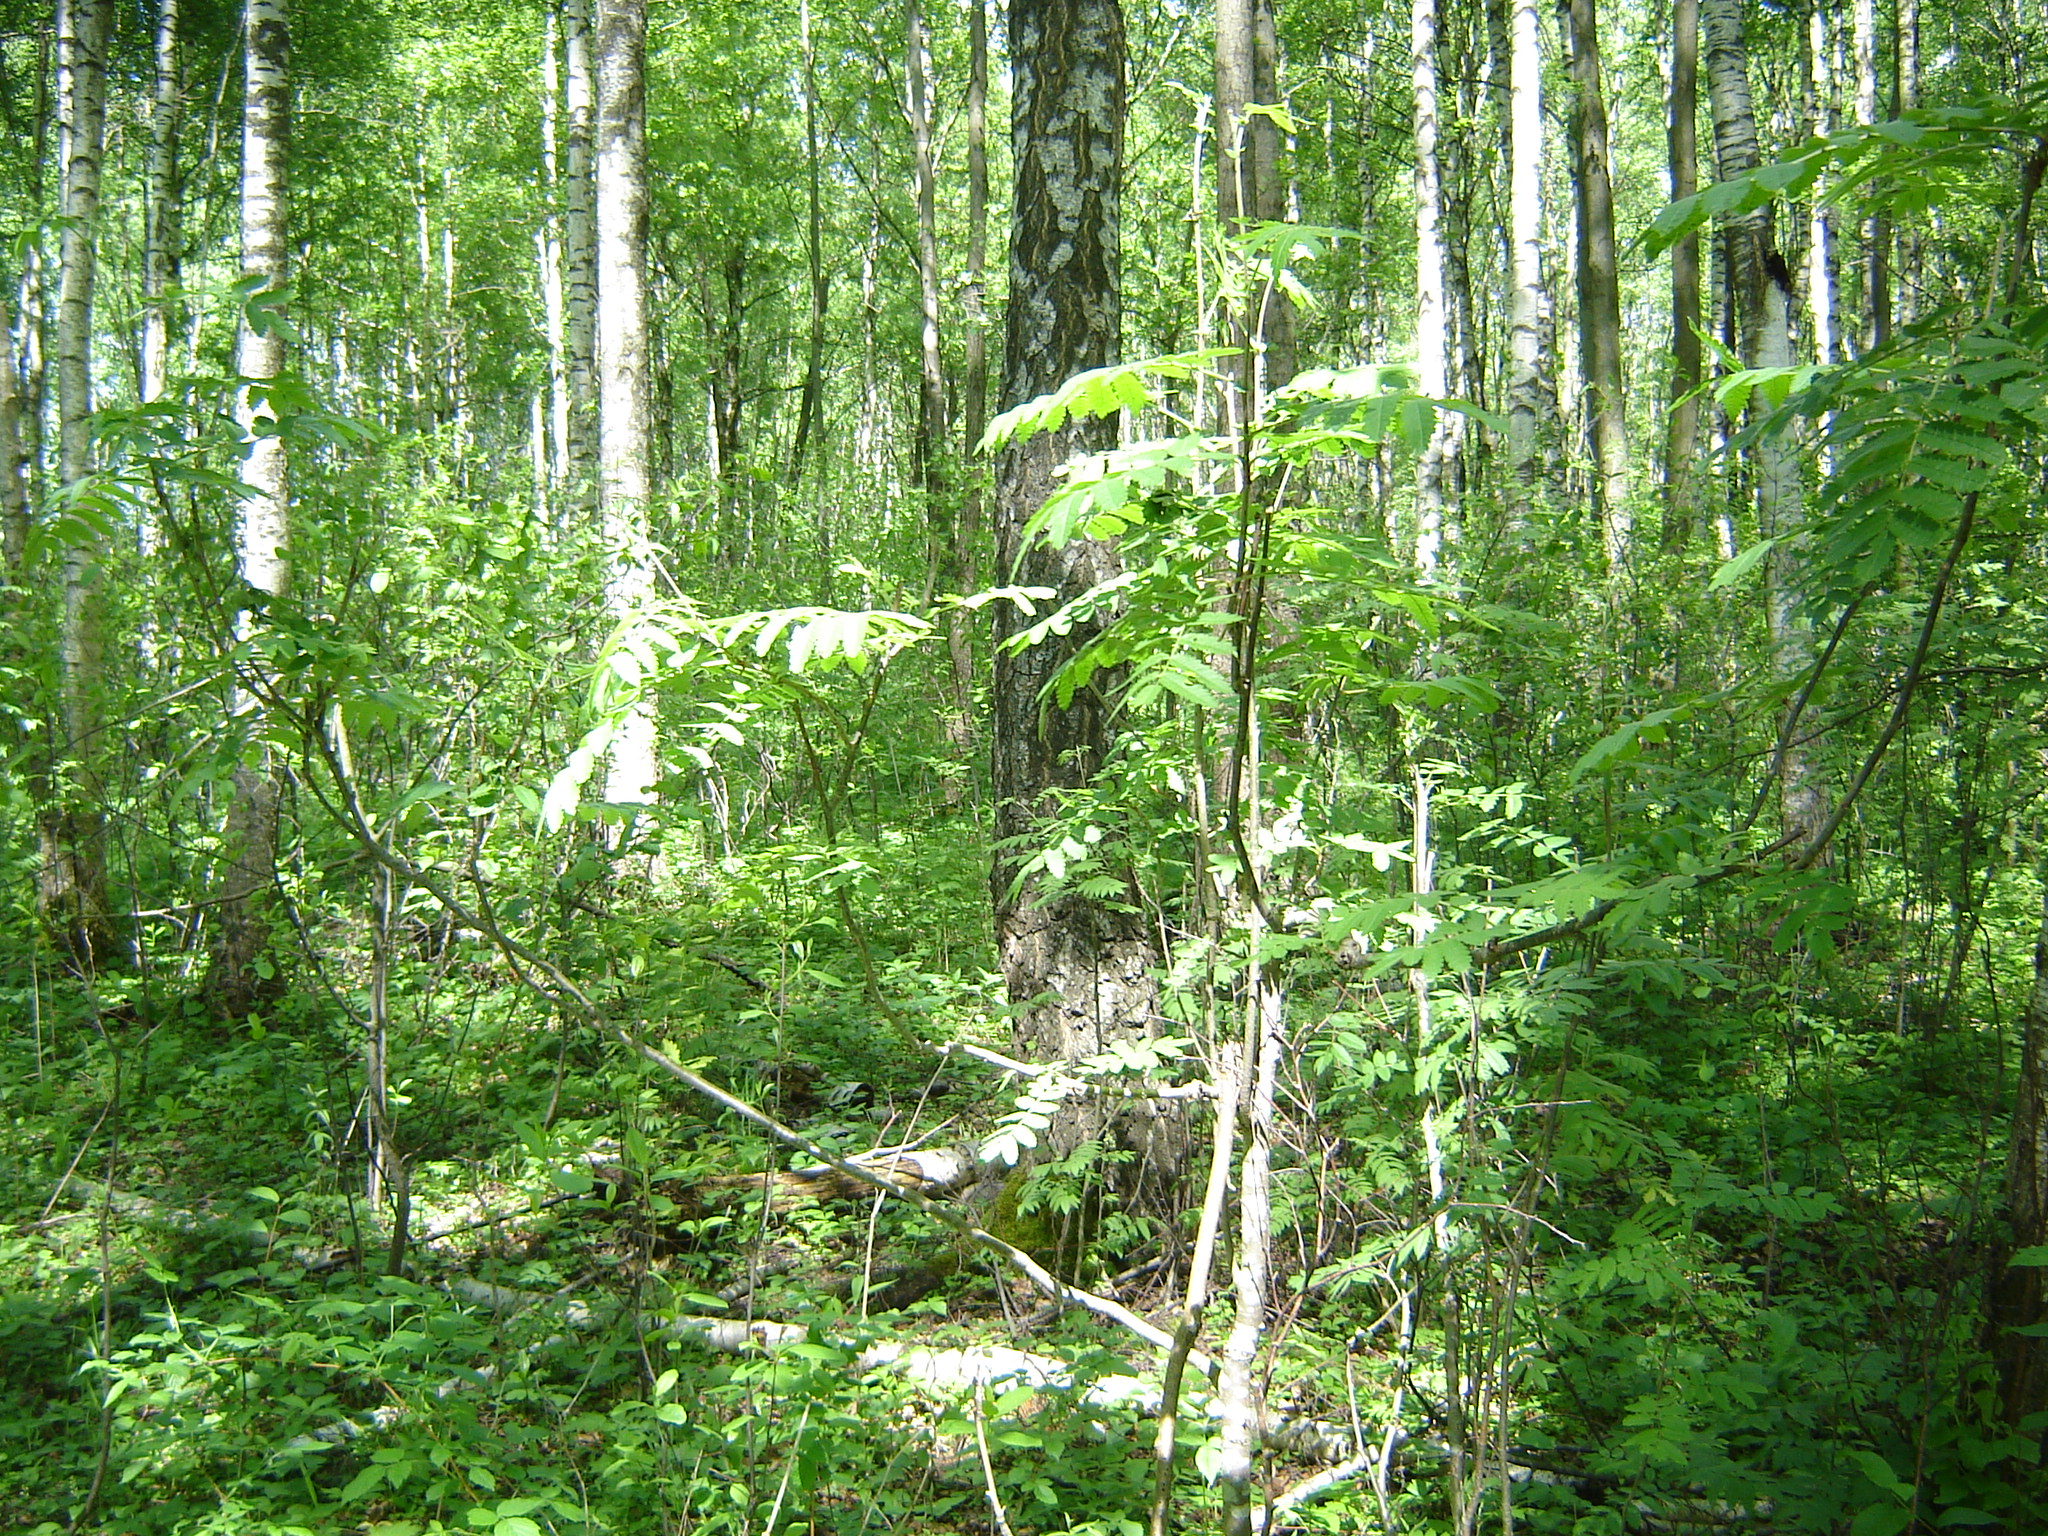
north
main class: Woodland
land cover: Broadleaved woodland
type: non-riverine alder, birch or aspen forest
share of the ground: > 75 %
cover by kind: broadleaved forest trees 95 %, herbaceous plants 5 %
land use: Forestry
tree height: > 5 m
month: May
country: LT
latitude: 55.8421
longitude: 25.2068
